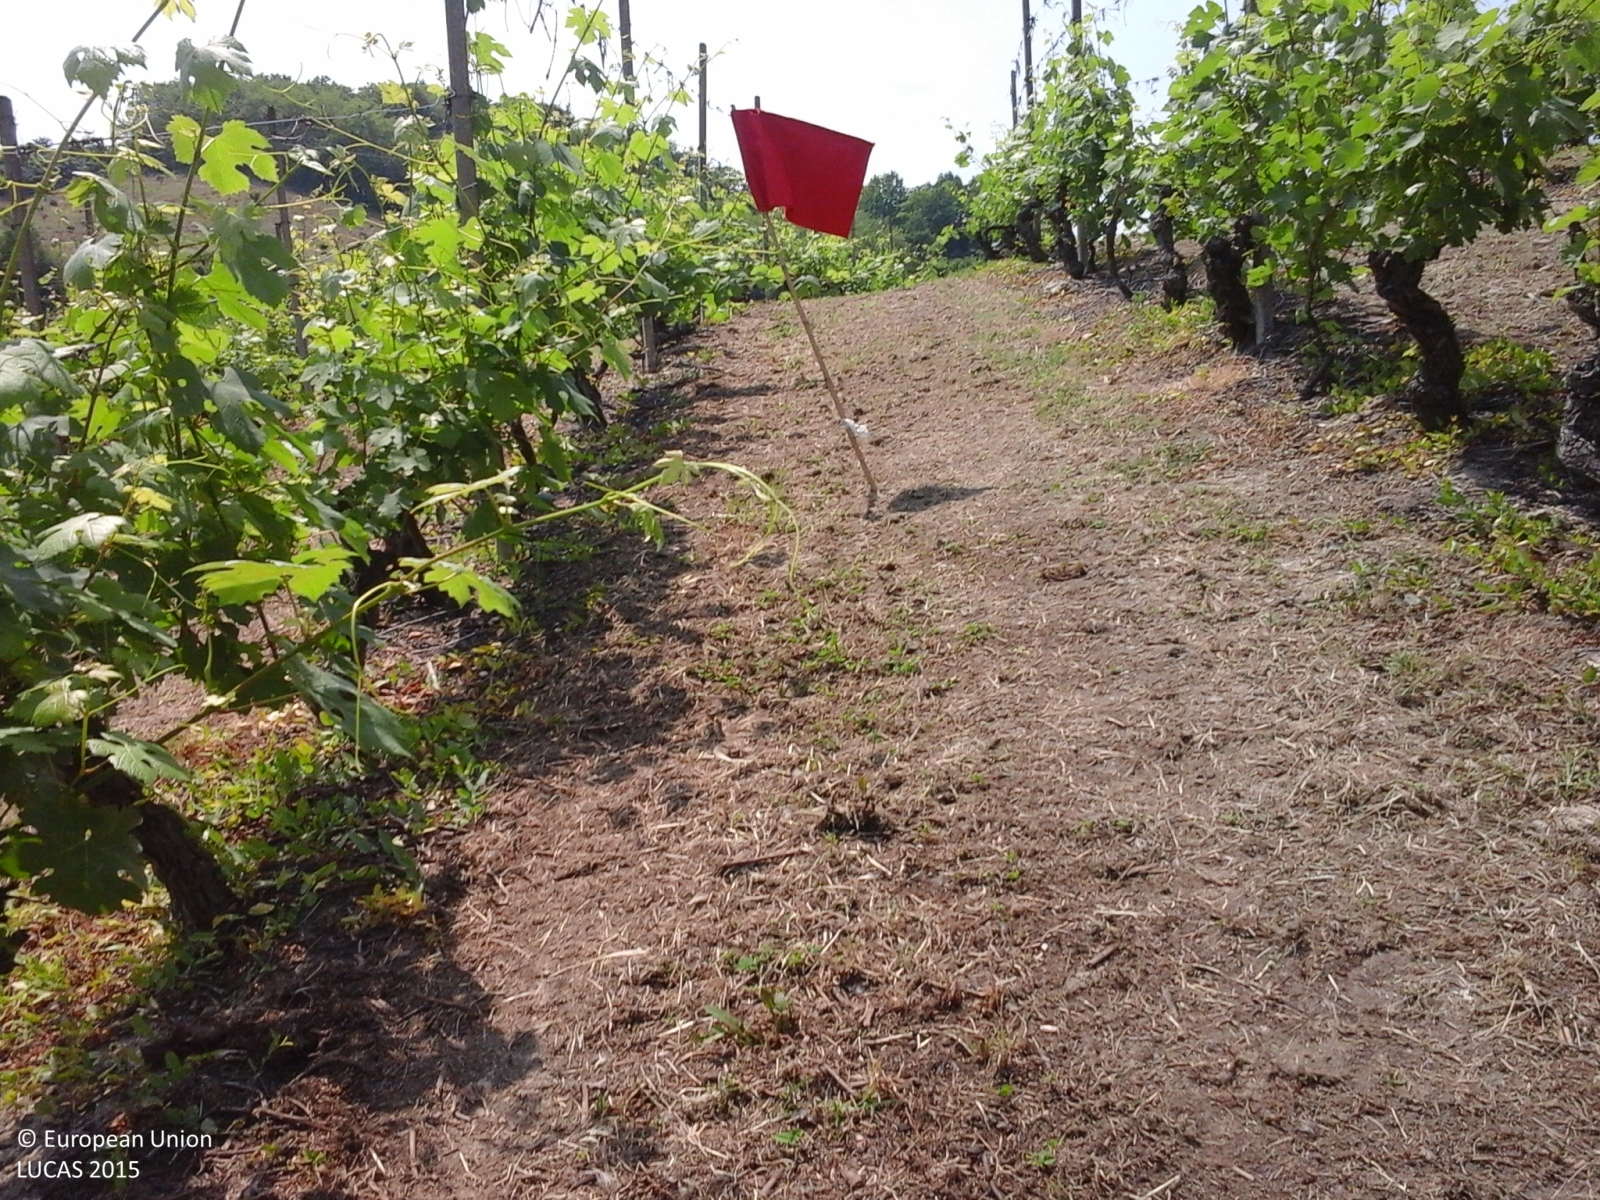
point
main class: Cropland
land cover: Vineyards
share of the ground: 25 - 50 %
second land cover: Grassland without tree/shrub cover
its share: 25 - 50 %
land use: Agriculture (excluding fallow land and kitchen gardens)
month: May
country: IT
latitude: 44.8372
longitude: 8.0430
